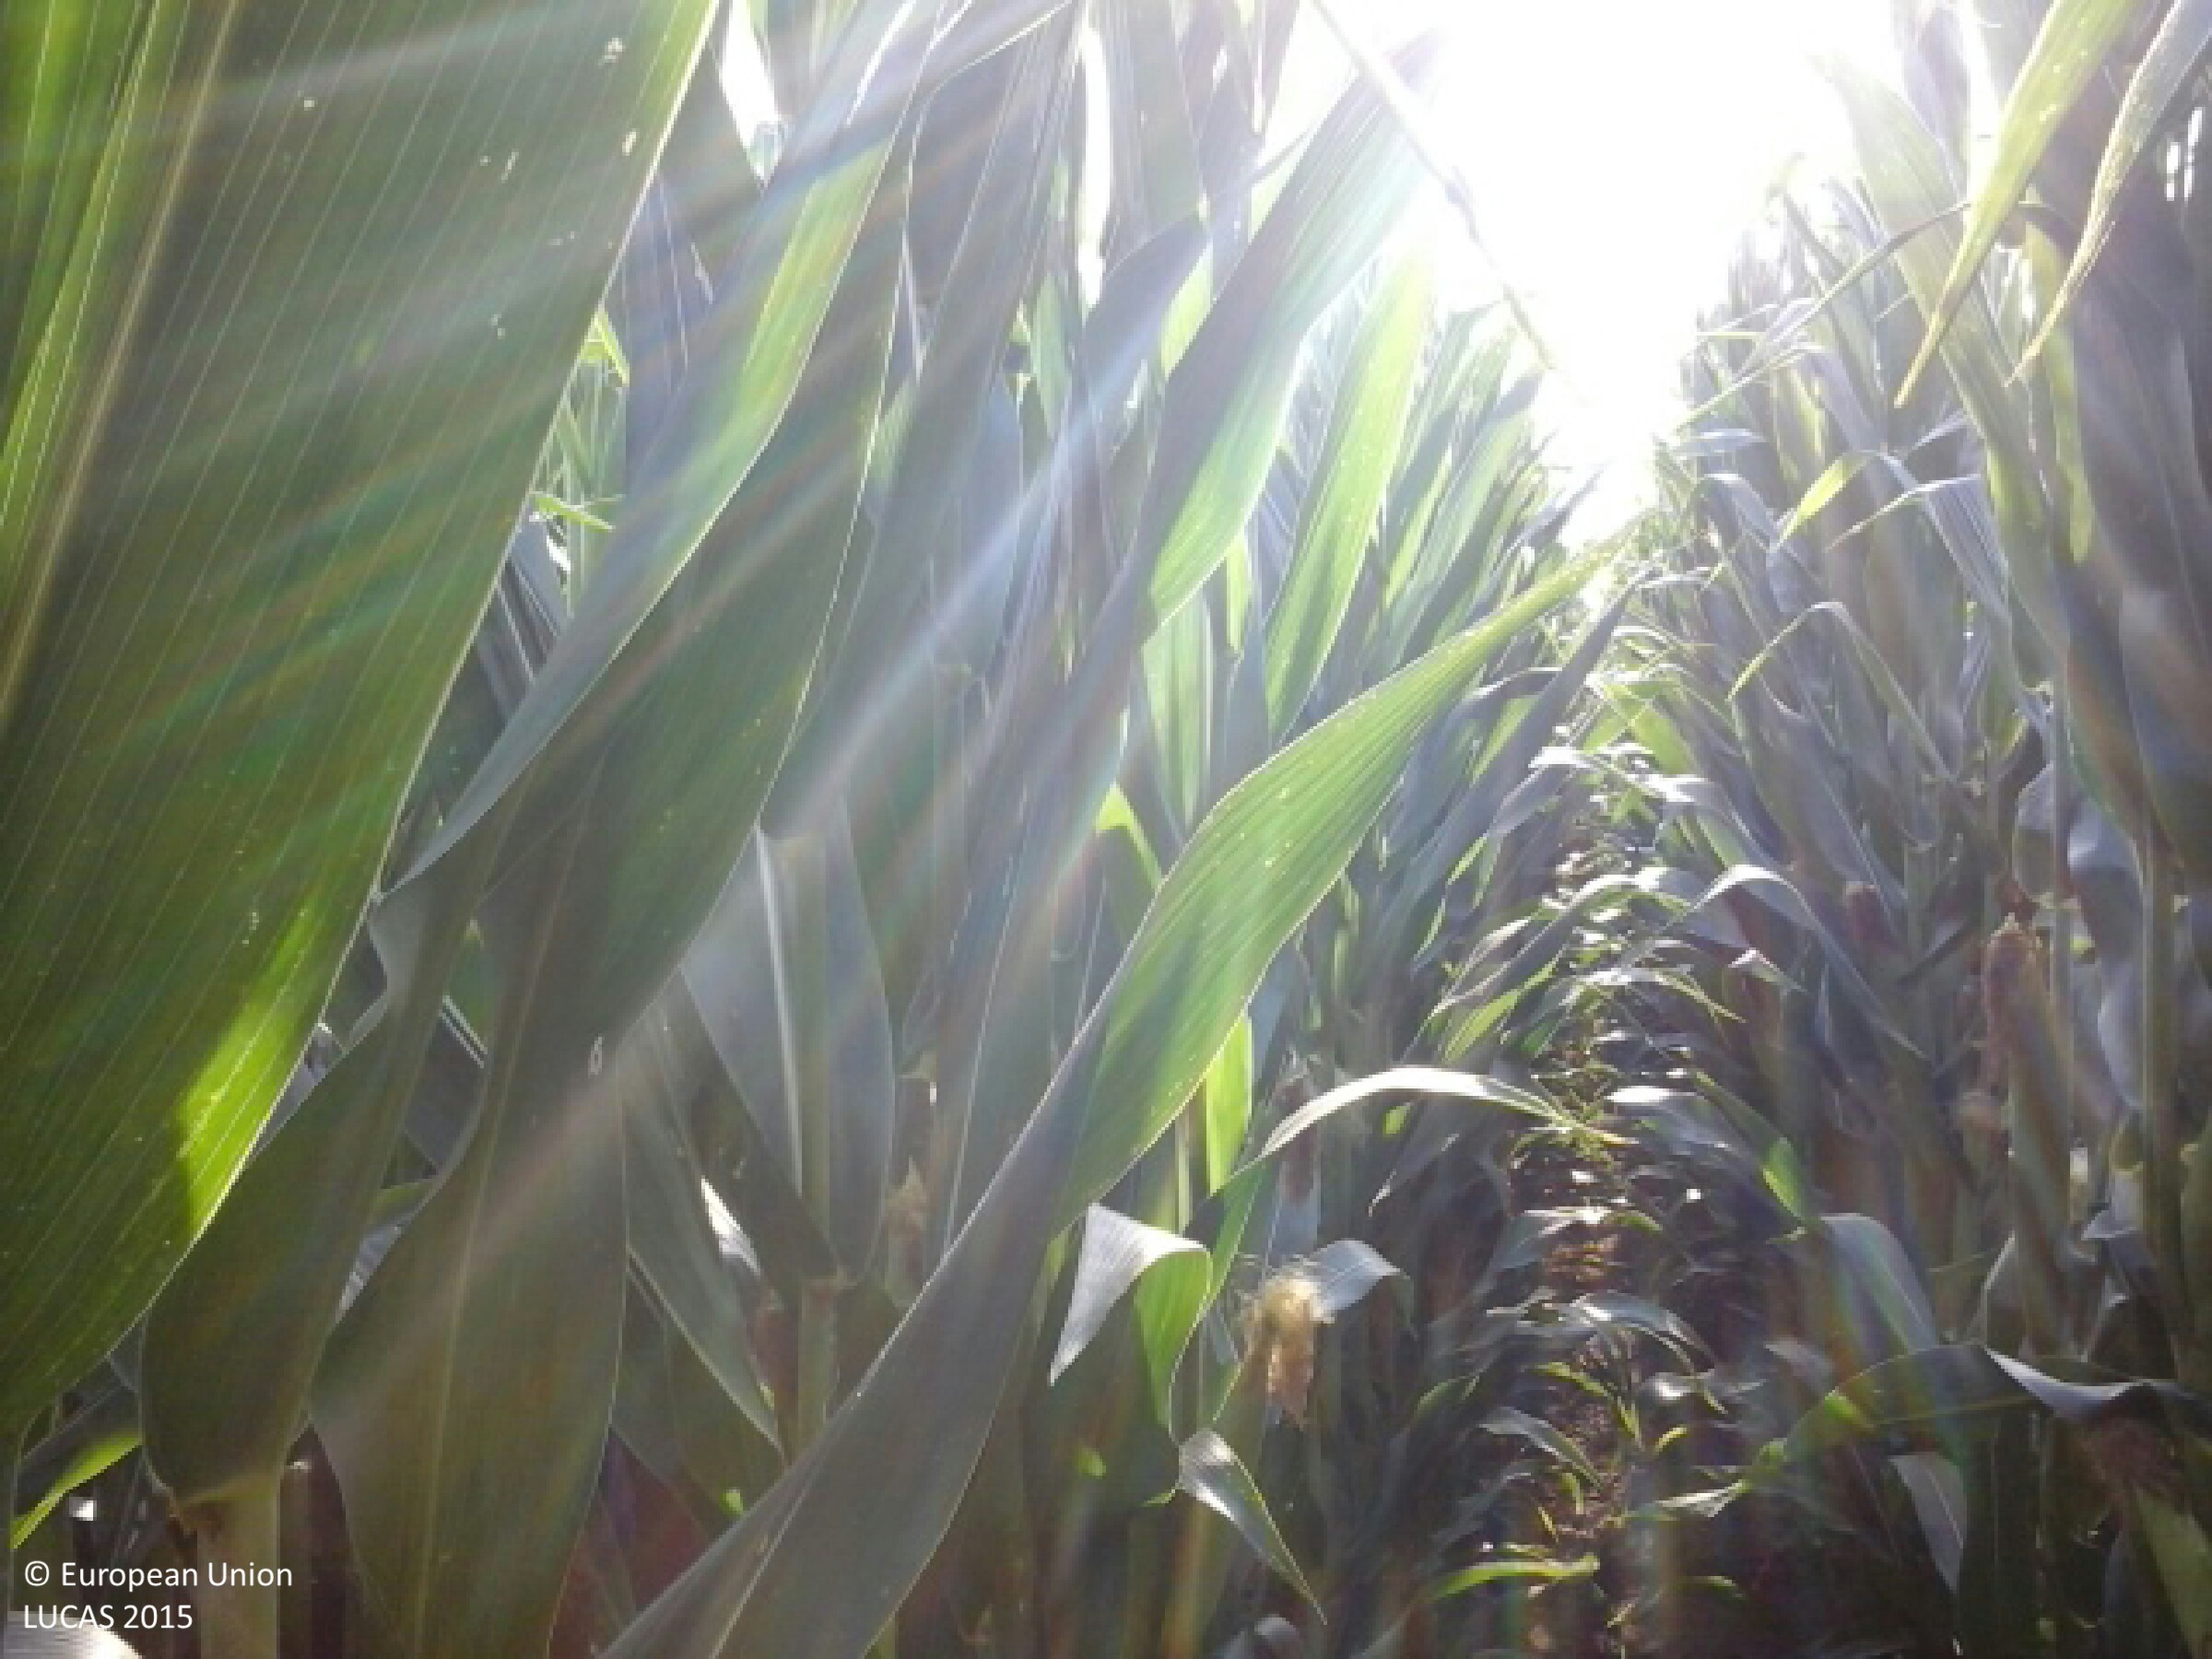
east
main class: Cropland
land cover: Maize
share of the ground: > 75 %
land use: Agriculture (excluding fallow land and kitchen gardens)
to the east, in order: Maize; Grass margins; Tracks; Grass margins; Maize
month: August
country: HU
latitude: 47.6839
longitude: 17.9373
